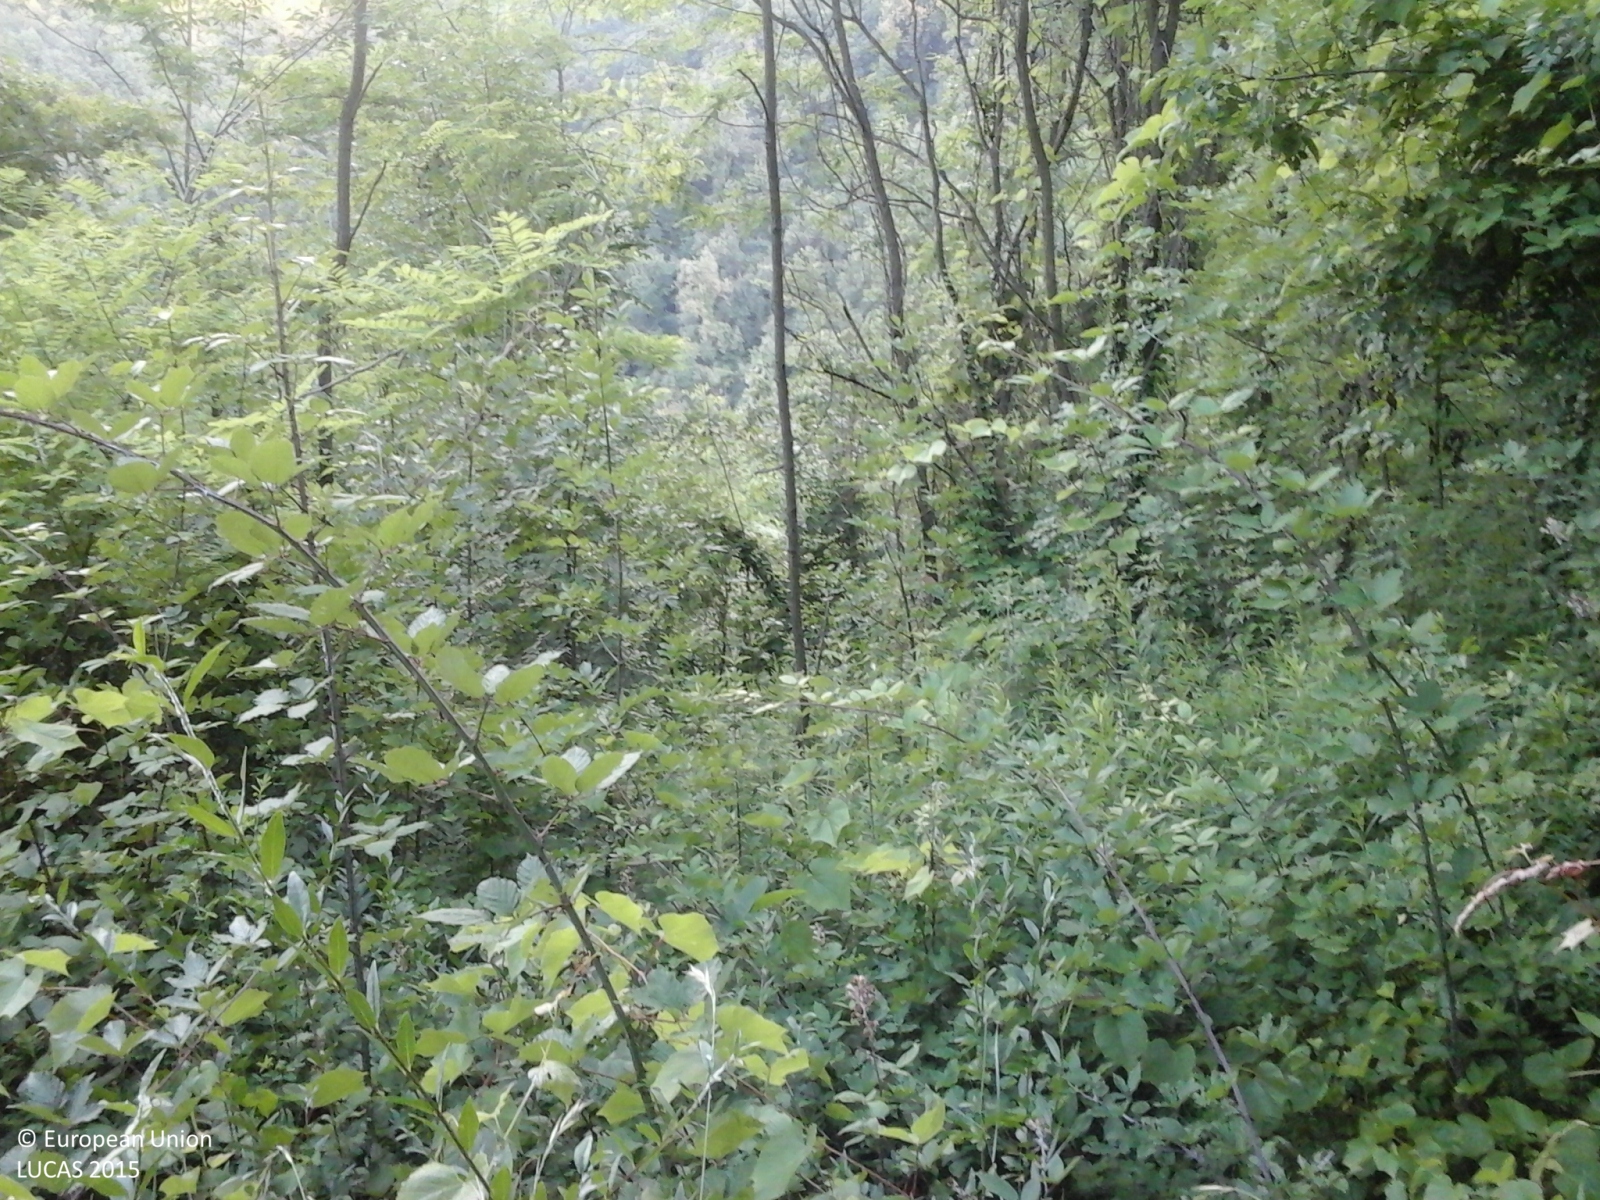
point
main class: Woodland
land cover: Broadleaved woodland
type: thermophilous deciduous forest
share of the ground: > 75 %
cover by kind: broadleaved forest trees 100 %
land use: Semi-natural and natural areas not in use
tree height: > 5 m
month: June
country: IT
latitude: 45.0583
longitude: 8.3142
